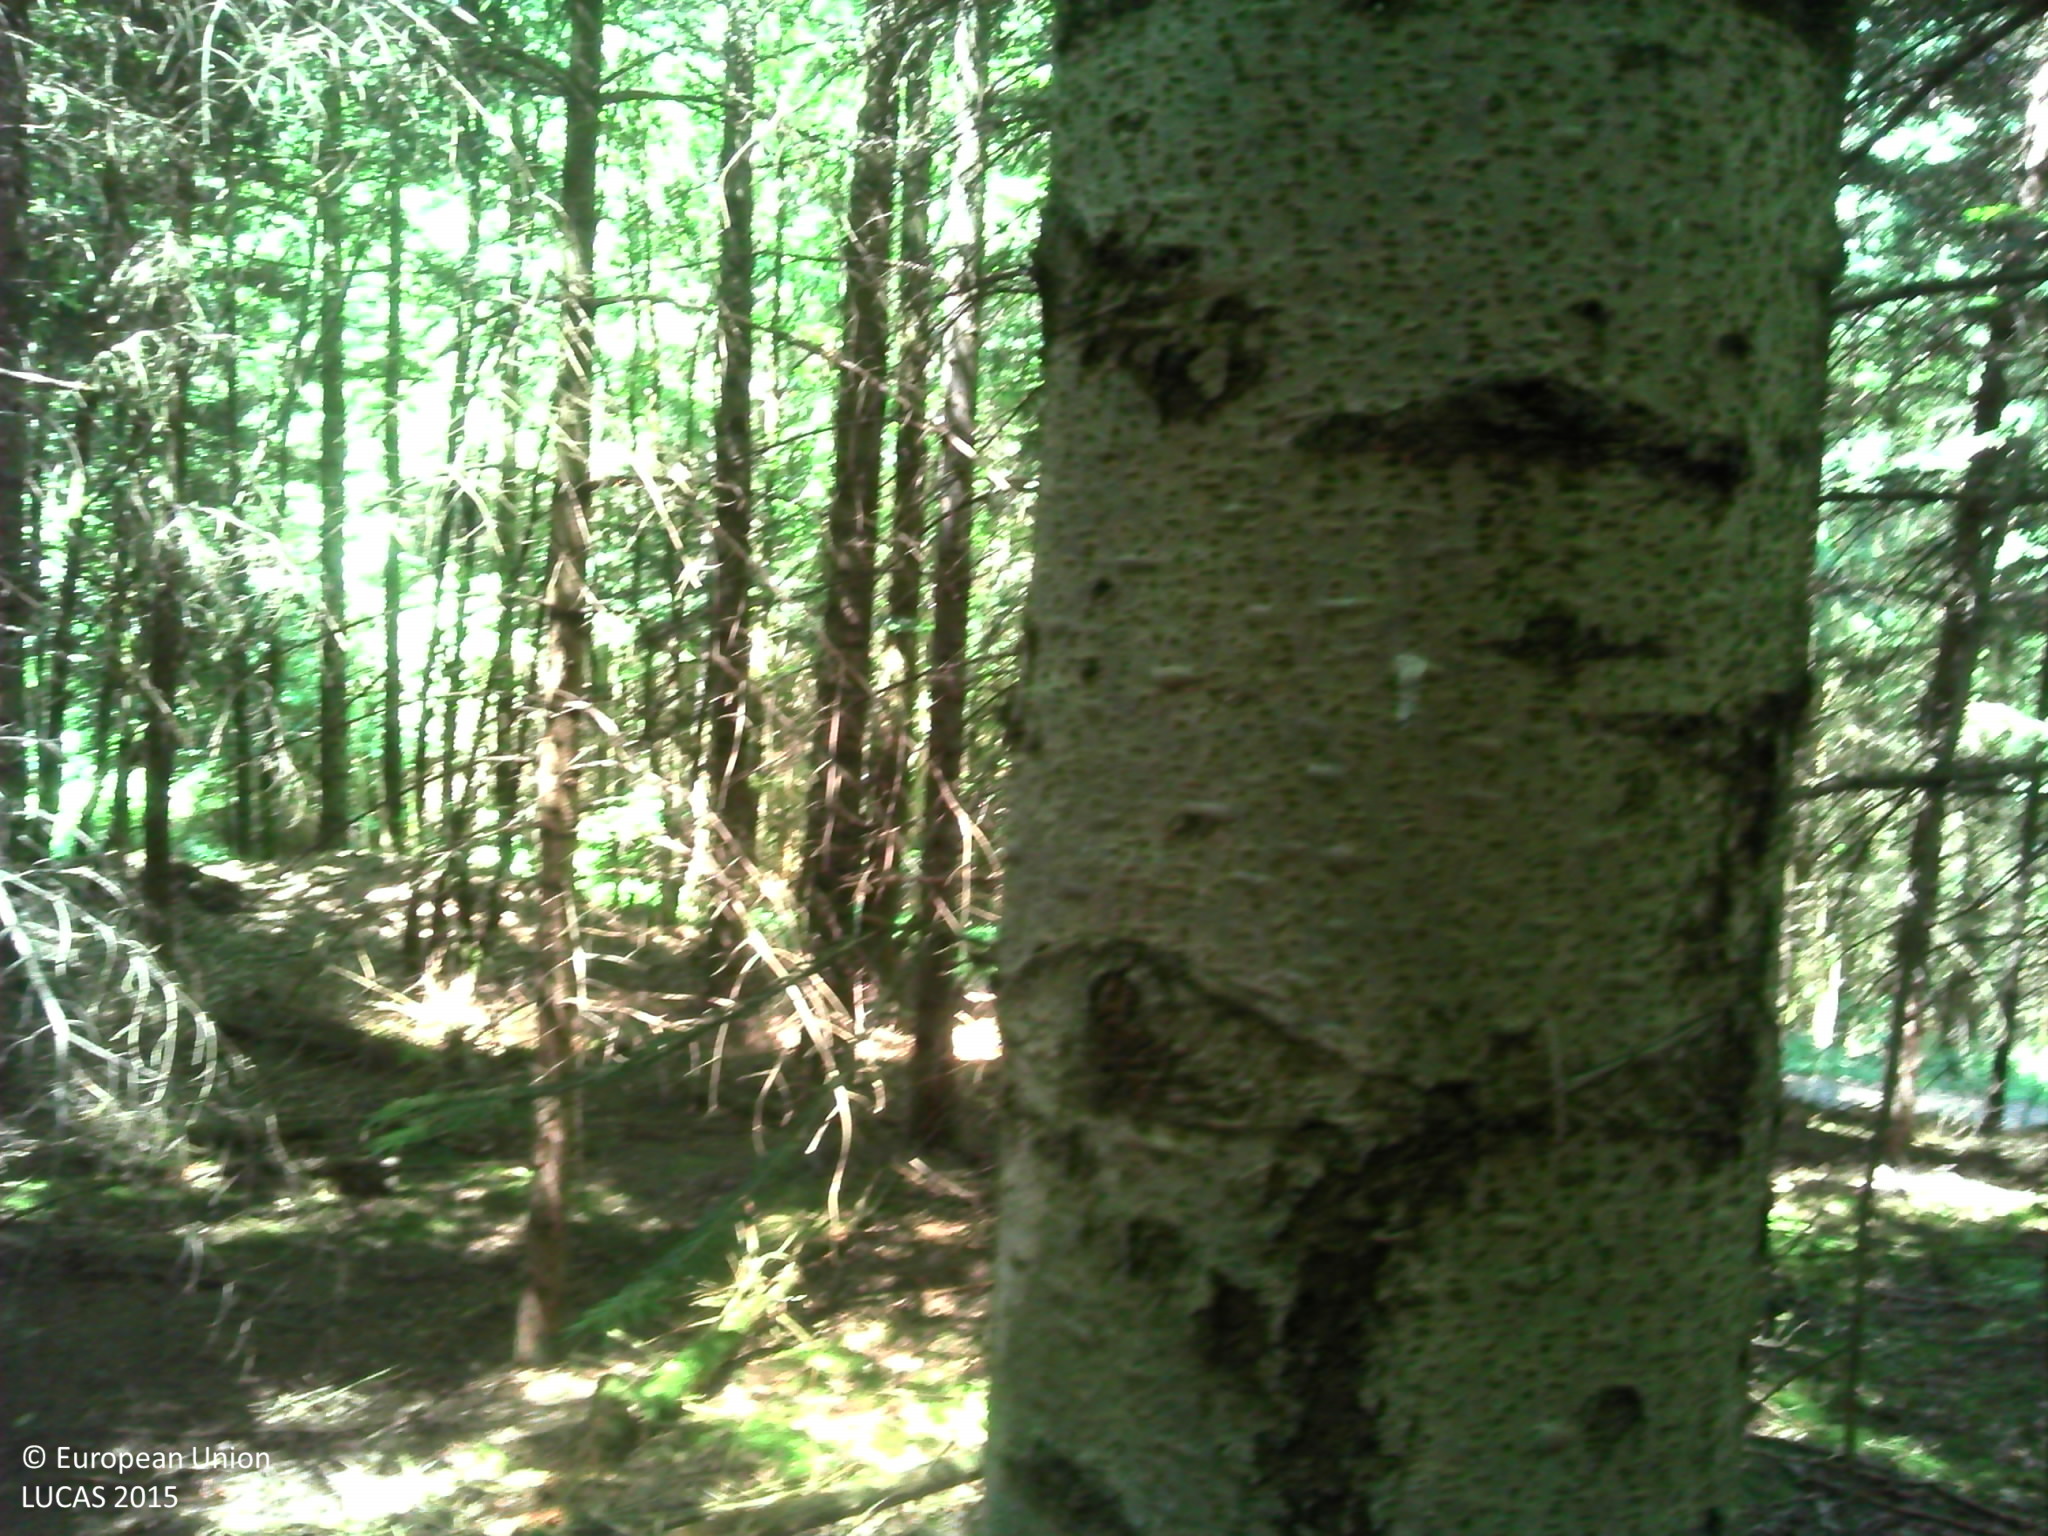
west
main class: Woodland
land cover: Spruce dominated coniferous woodland
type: exotic forest
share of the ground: > 75 %
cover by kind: coniferous forest trees 100 %
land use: Forestry
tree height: > 5 m
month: June
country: FR
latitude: 43.7577
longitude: 2.5662
